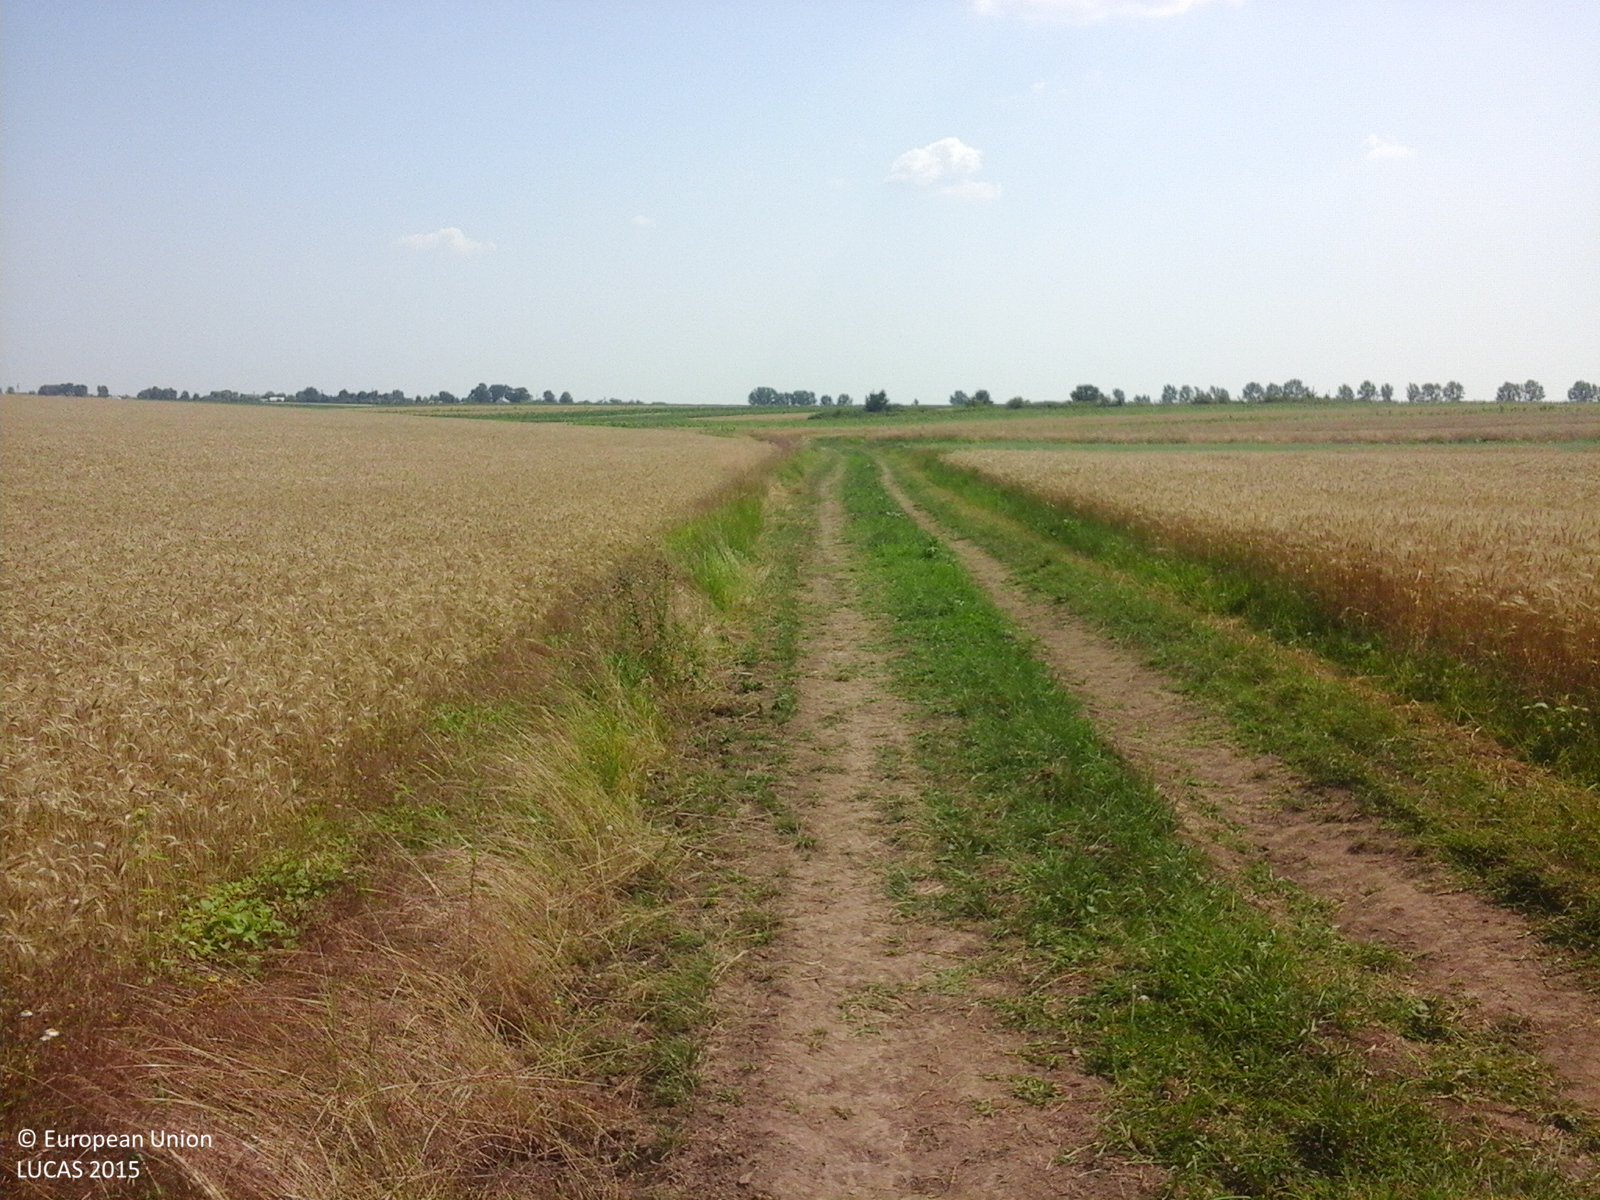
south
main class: Cropland
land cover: Common wheat
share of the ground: > 75 %
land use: Agriculture (excluding fallow land and kitchen gardens)
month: July
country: RO
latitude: 44.6809
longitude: 24.4927
